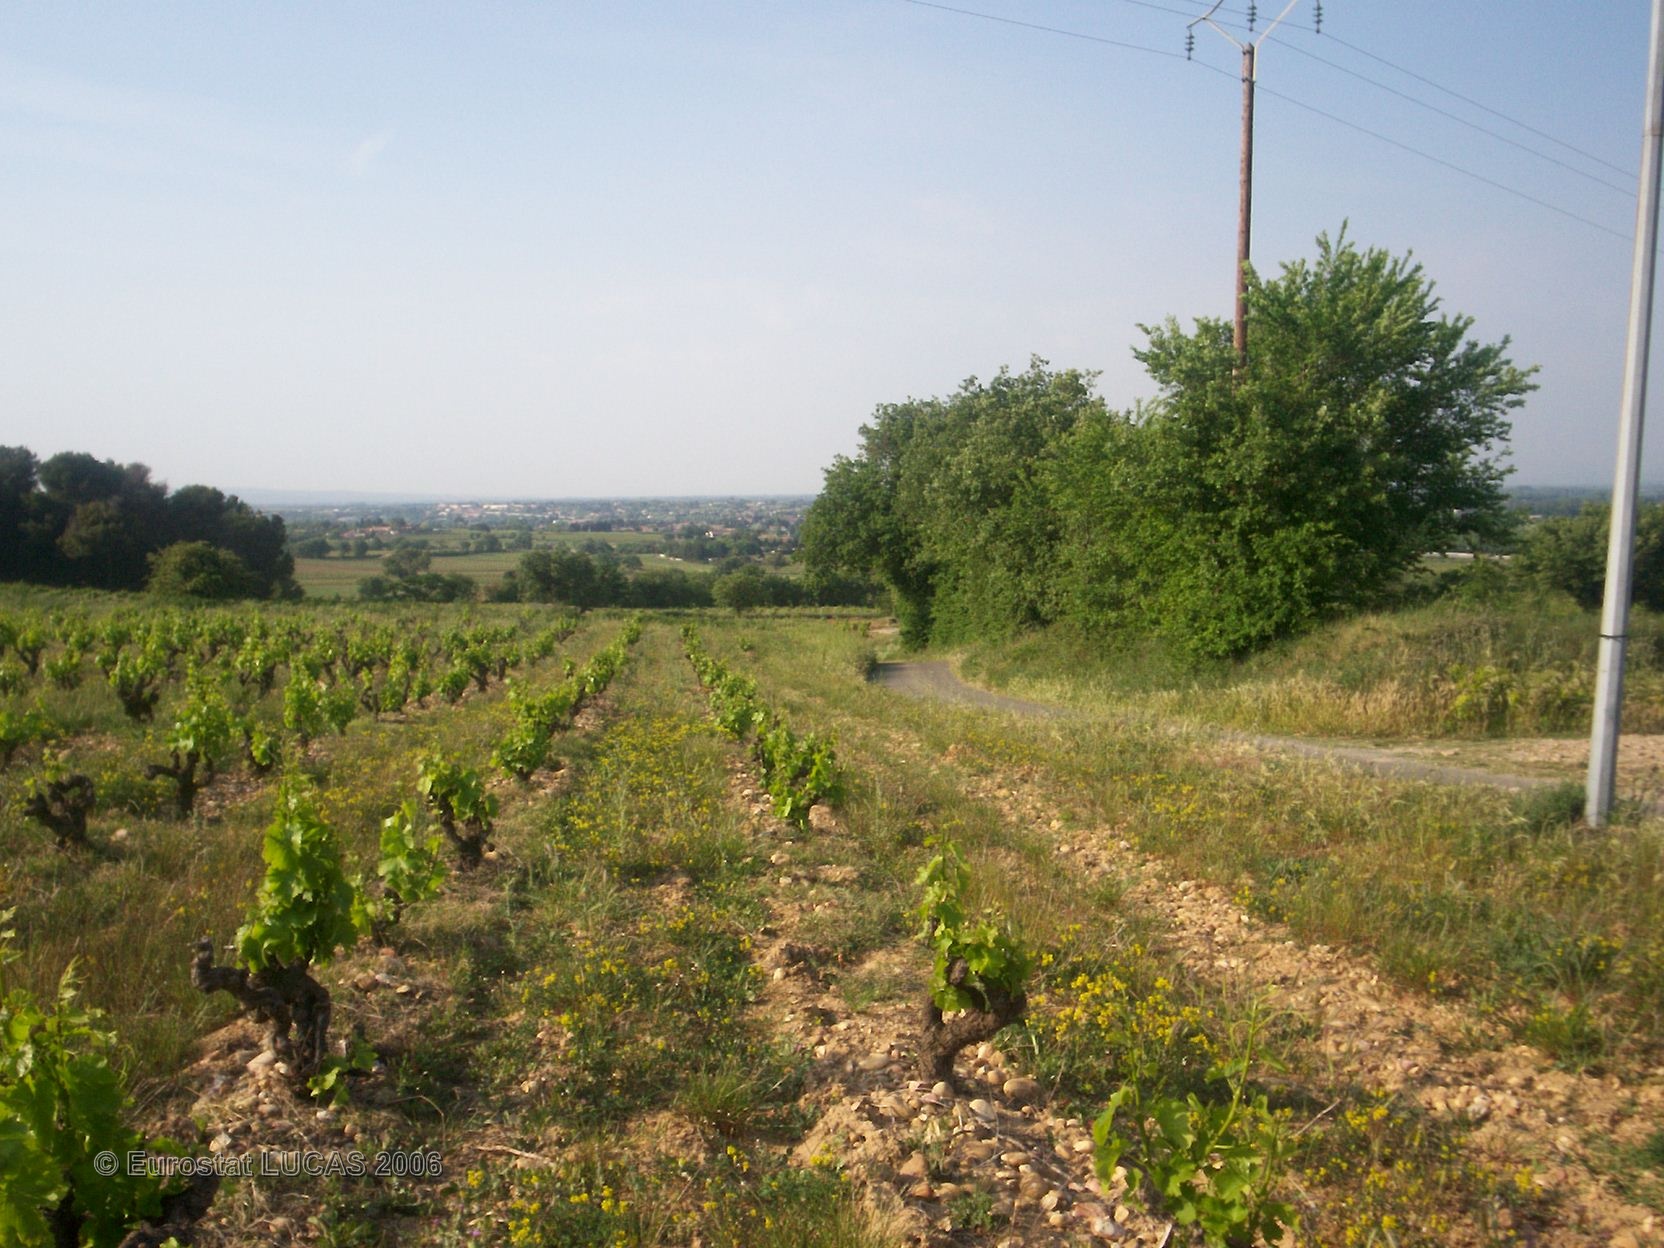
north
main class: Cropland
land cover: Vineyards
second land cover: Grassland without tree/shrub cover
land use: Agriculture (excluding fallow land and kitchen gardens)
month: May
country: FR
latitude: 44.0614
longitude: 4.8774
